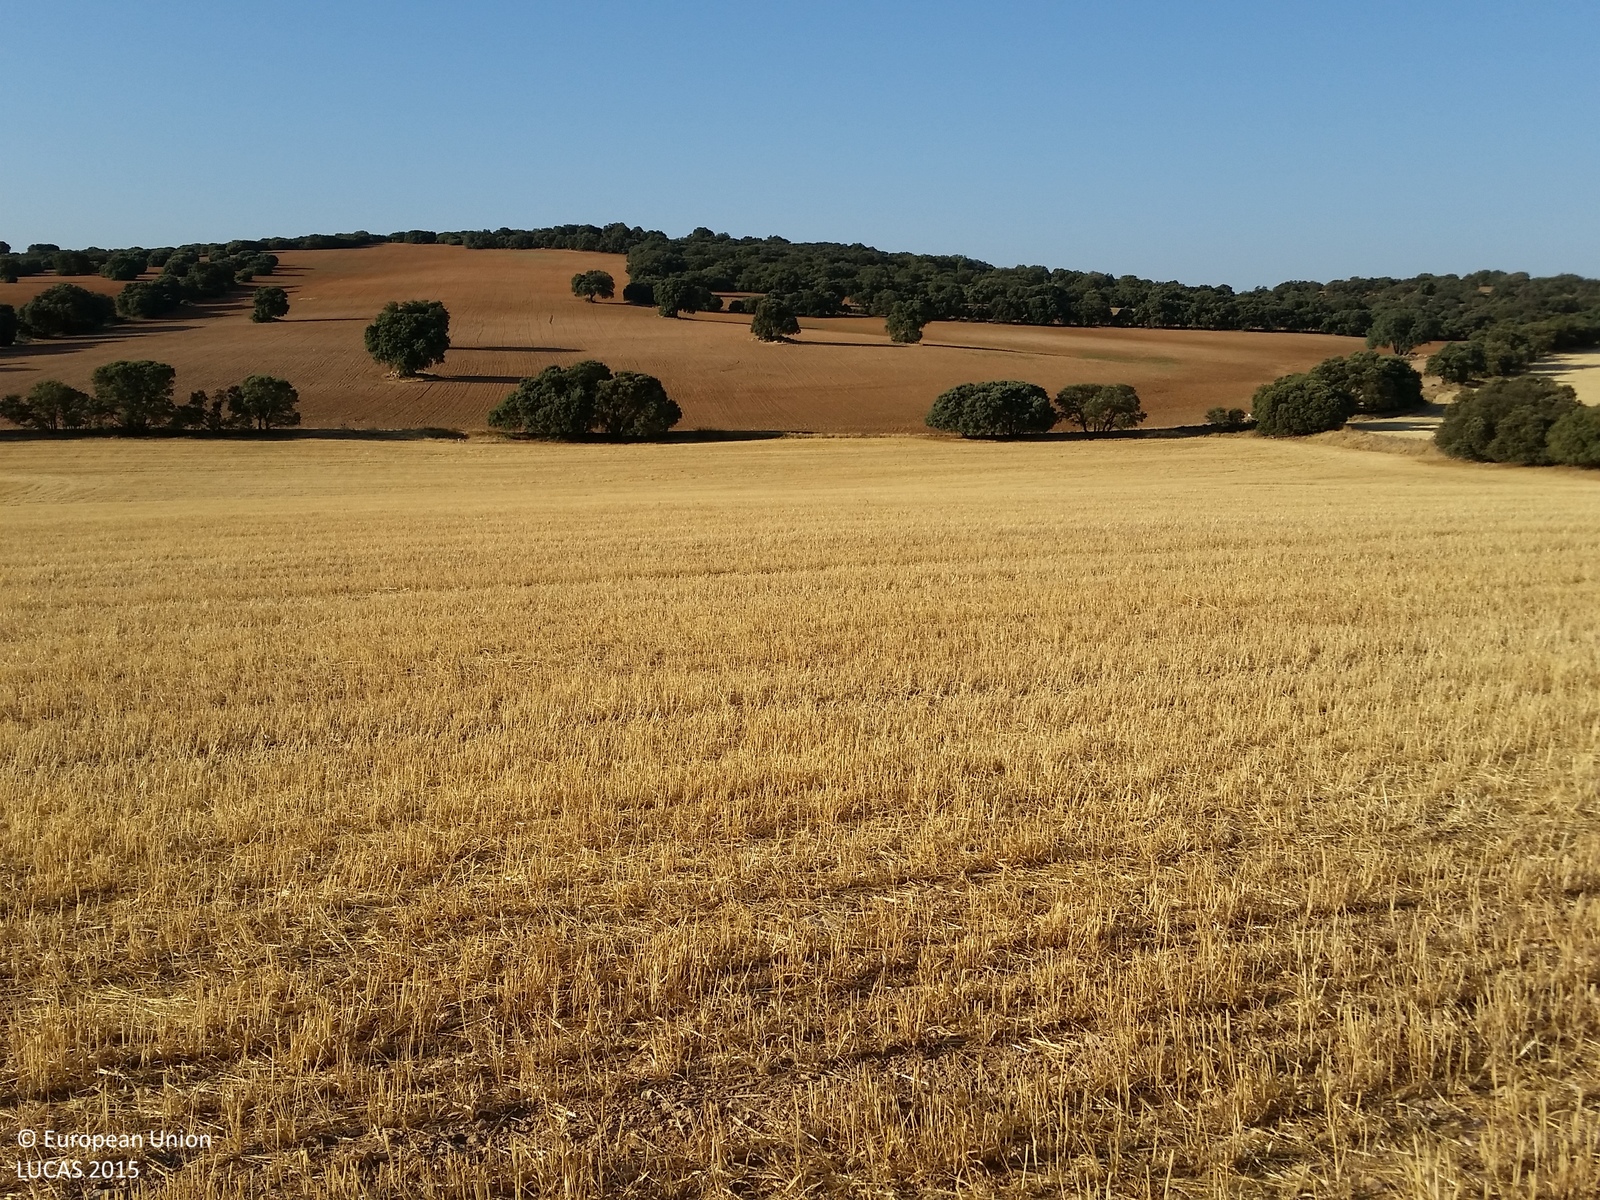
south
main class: Cropland
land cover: Oats
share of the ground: < 10 %
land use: Agriculture (excluding fallow land and kitchen gardens)
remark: Harvested field
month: July
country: ES
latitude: 39.0443
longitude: -2.6359
